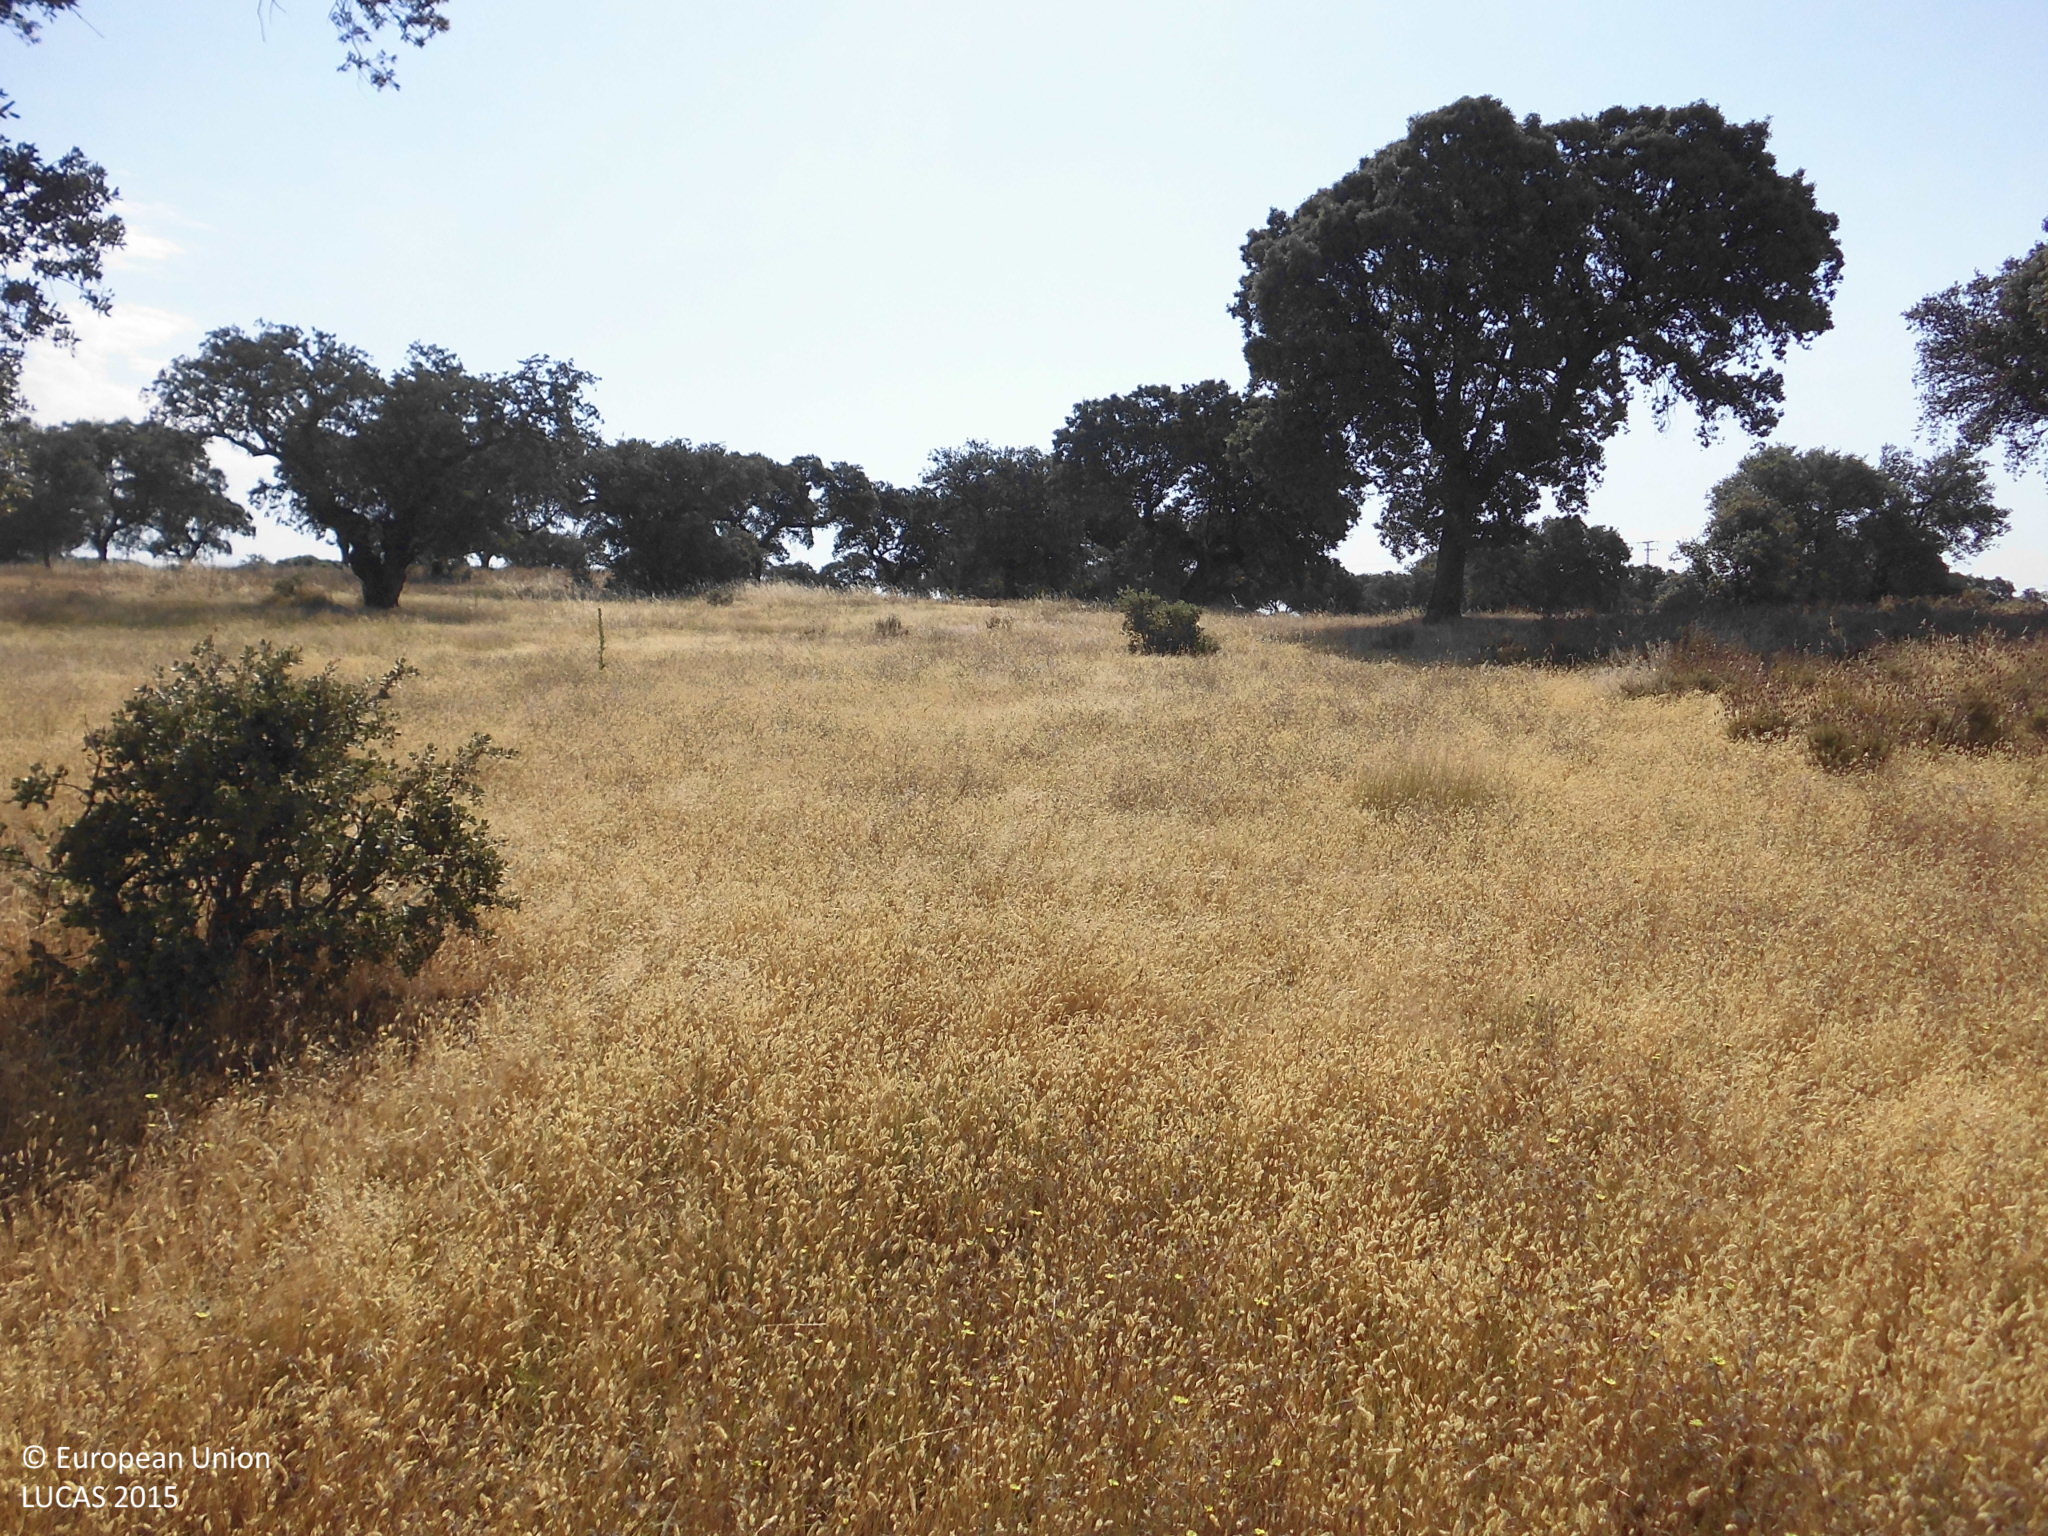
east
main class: Woodland
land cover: Broadleaved woodland
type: broadleaved evergreen forest
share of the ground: 50 - 75 %
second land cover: Grassland without tree/shrub cover
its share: > 75 %
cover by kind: herbaceous plants 70 %, broadleaved forest trees 25 %, shrubs 5 %
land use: Forestry
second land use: Agriculture (excluding fallow land and kitchen gardens)
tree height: > 5 m
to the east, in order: Broadleaved woodland; Grassland without tree/shrub cover; Fences; Other structural elements; Broadleaved woodland
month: June
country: ES
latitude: 40.0322
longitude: -5.4222
